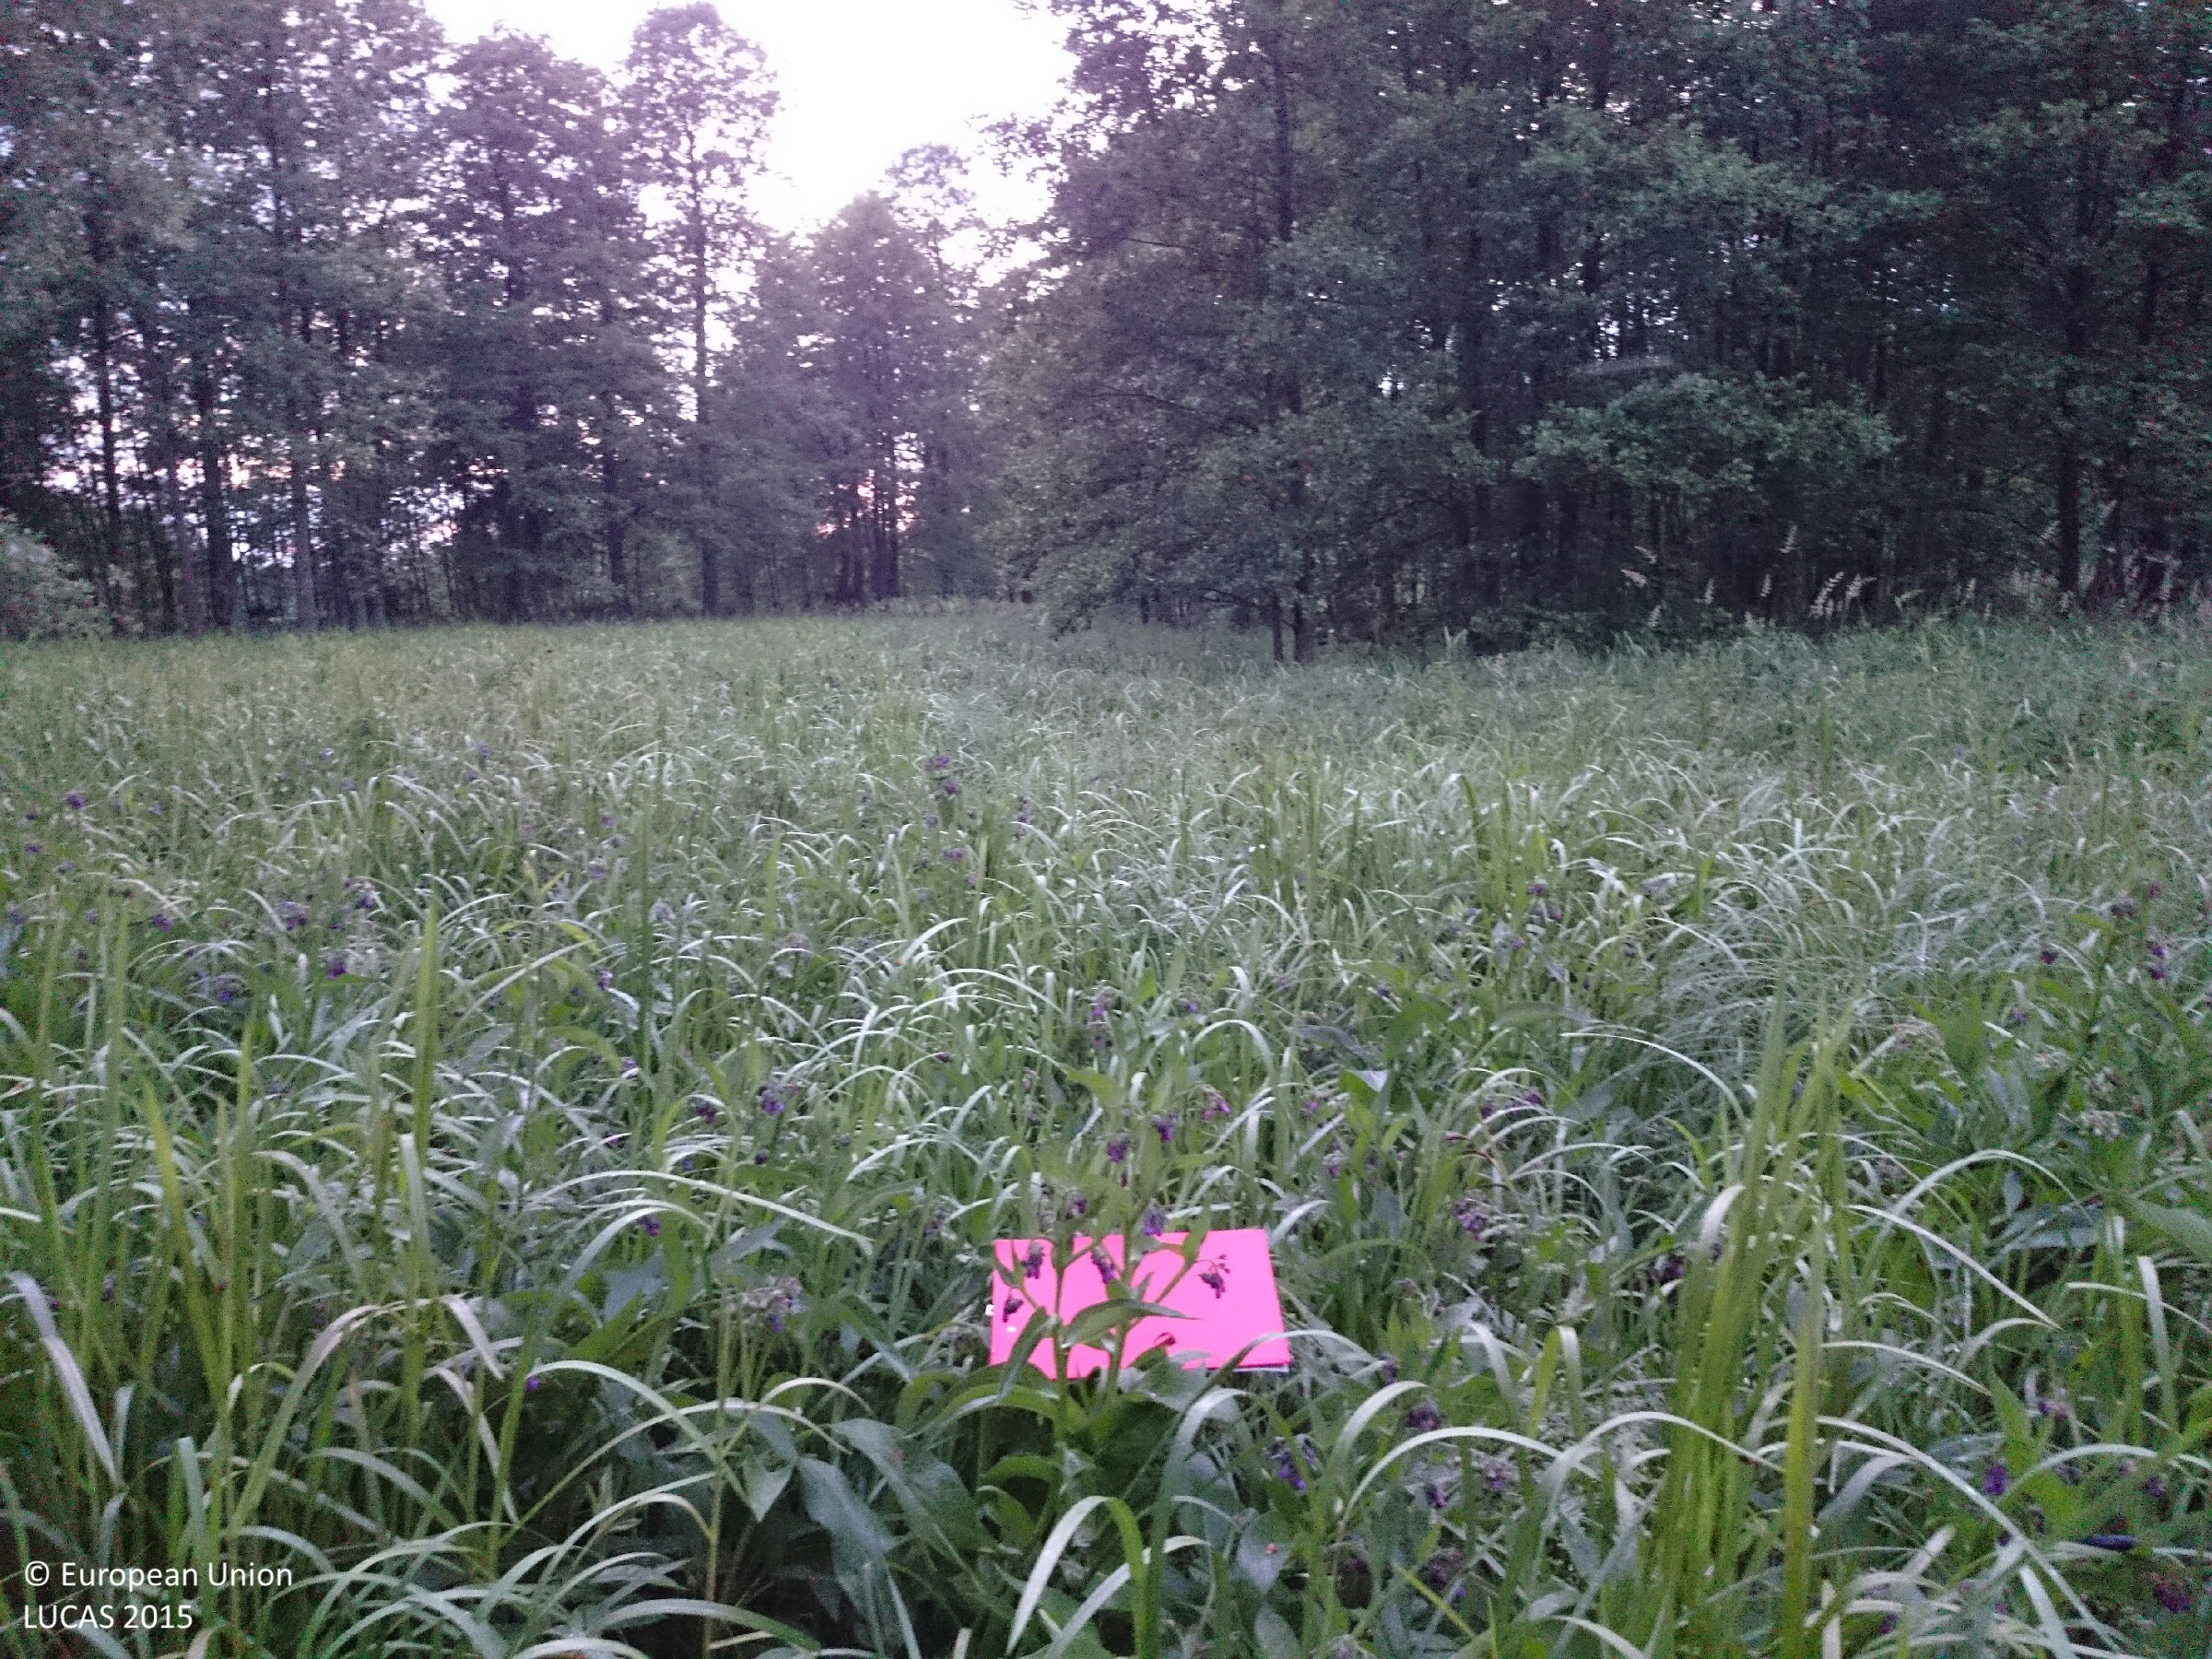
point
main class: Grassland
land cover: Grassland without tree/shrub cover
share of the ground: > 75 %
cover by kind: herbaceous plants 100 %
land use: Forestry
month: June
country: PL
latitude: 52.7641
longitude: 15.6803
